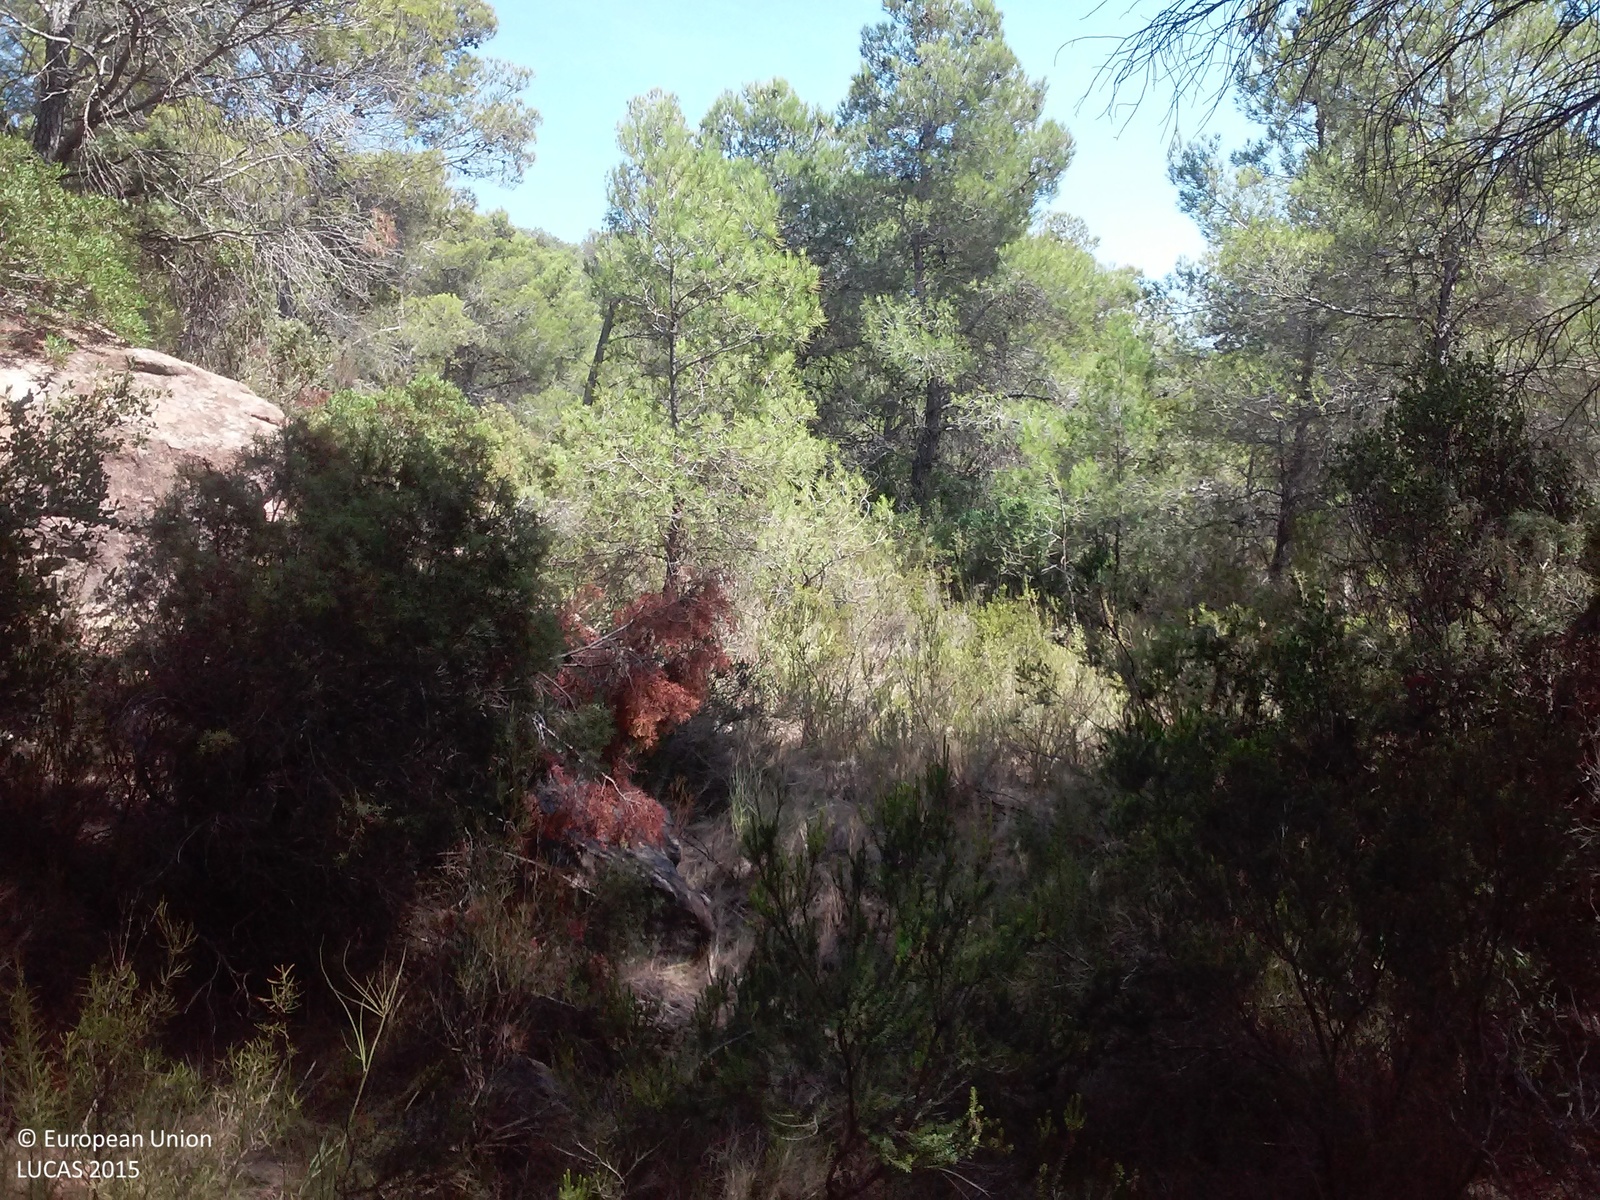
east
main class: Woodland
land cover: Pine dominated coniferous woodland
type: coniferous forest of the mediterranean region
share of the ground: 25 - 50 %
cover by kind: coniferous forest trees 40 %, shrubs 30 %, herbaceous plants 20 %, lichens and mosses 10 %
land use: Semi-natural and natural areas not in use
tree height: > 5 m
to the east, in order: Pine dominated coniferous woodland
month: August
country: ES
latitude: 41.1358
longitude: 0.5203
